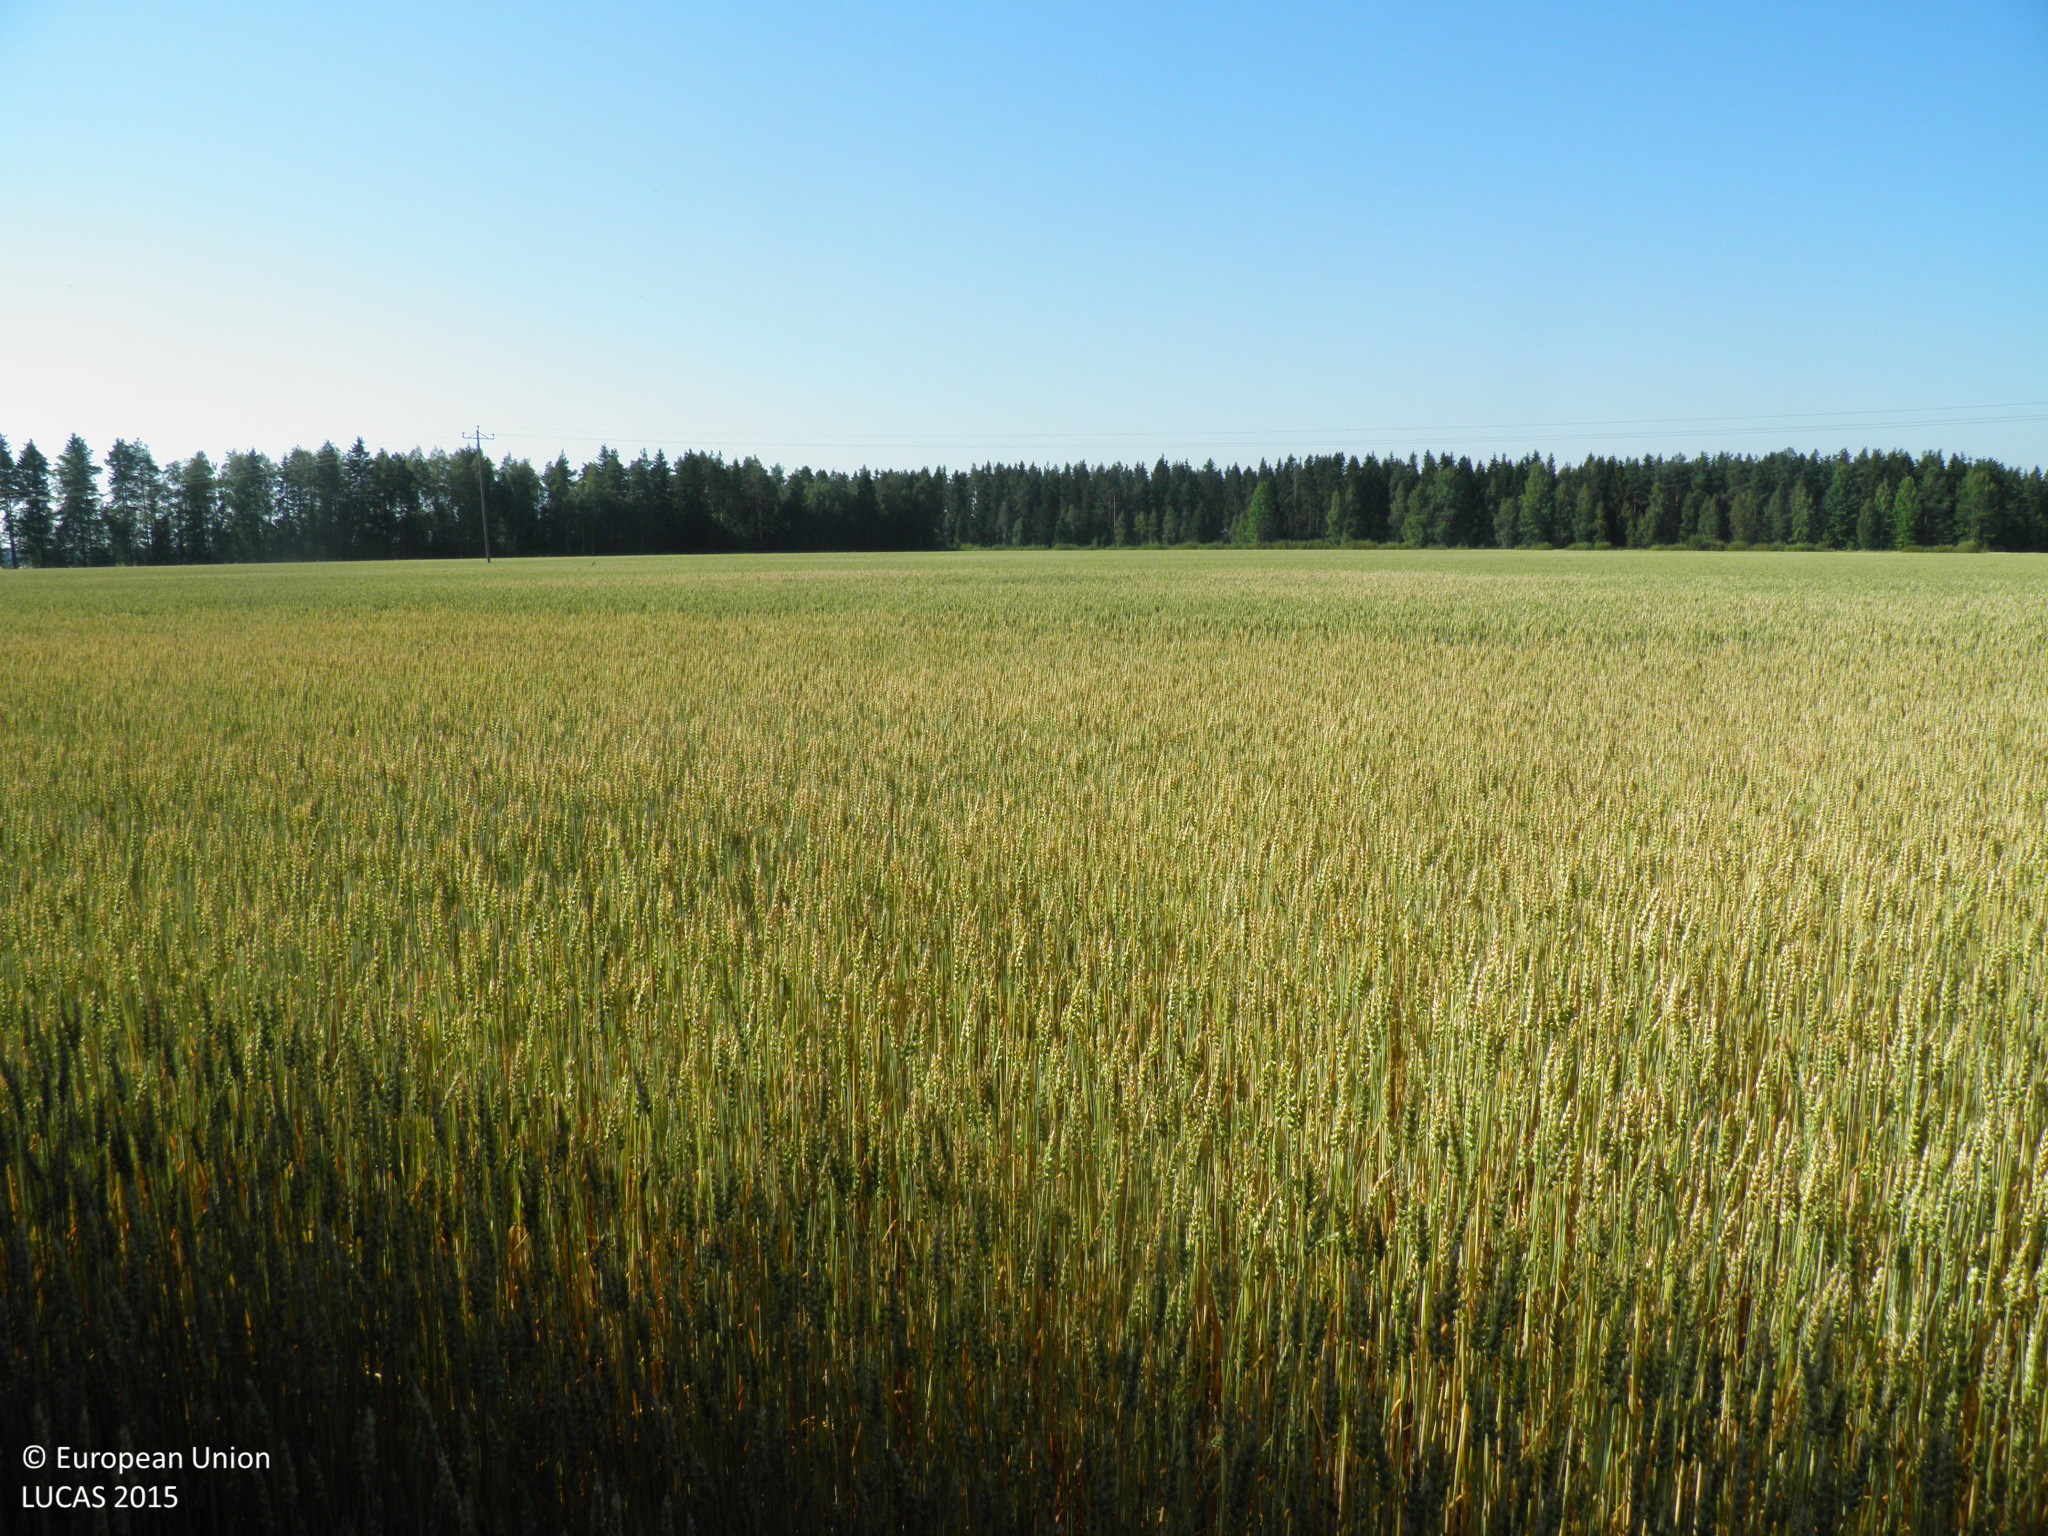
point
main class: Cropland
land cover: Common wheat
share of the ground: > 75 %
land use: Agriculture (excluding fallow land and kitchen gardens)
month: August
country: FI
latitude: 60.7276
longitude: 23.0021
